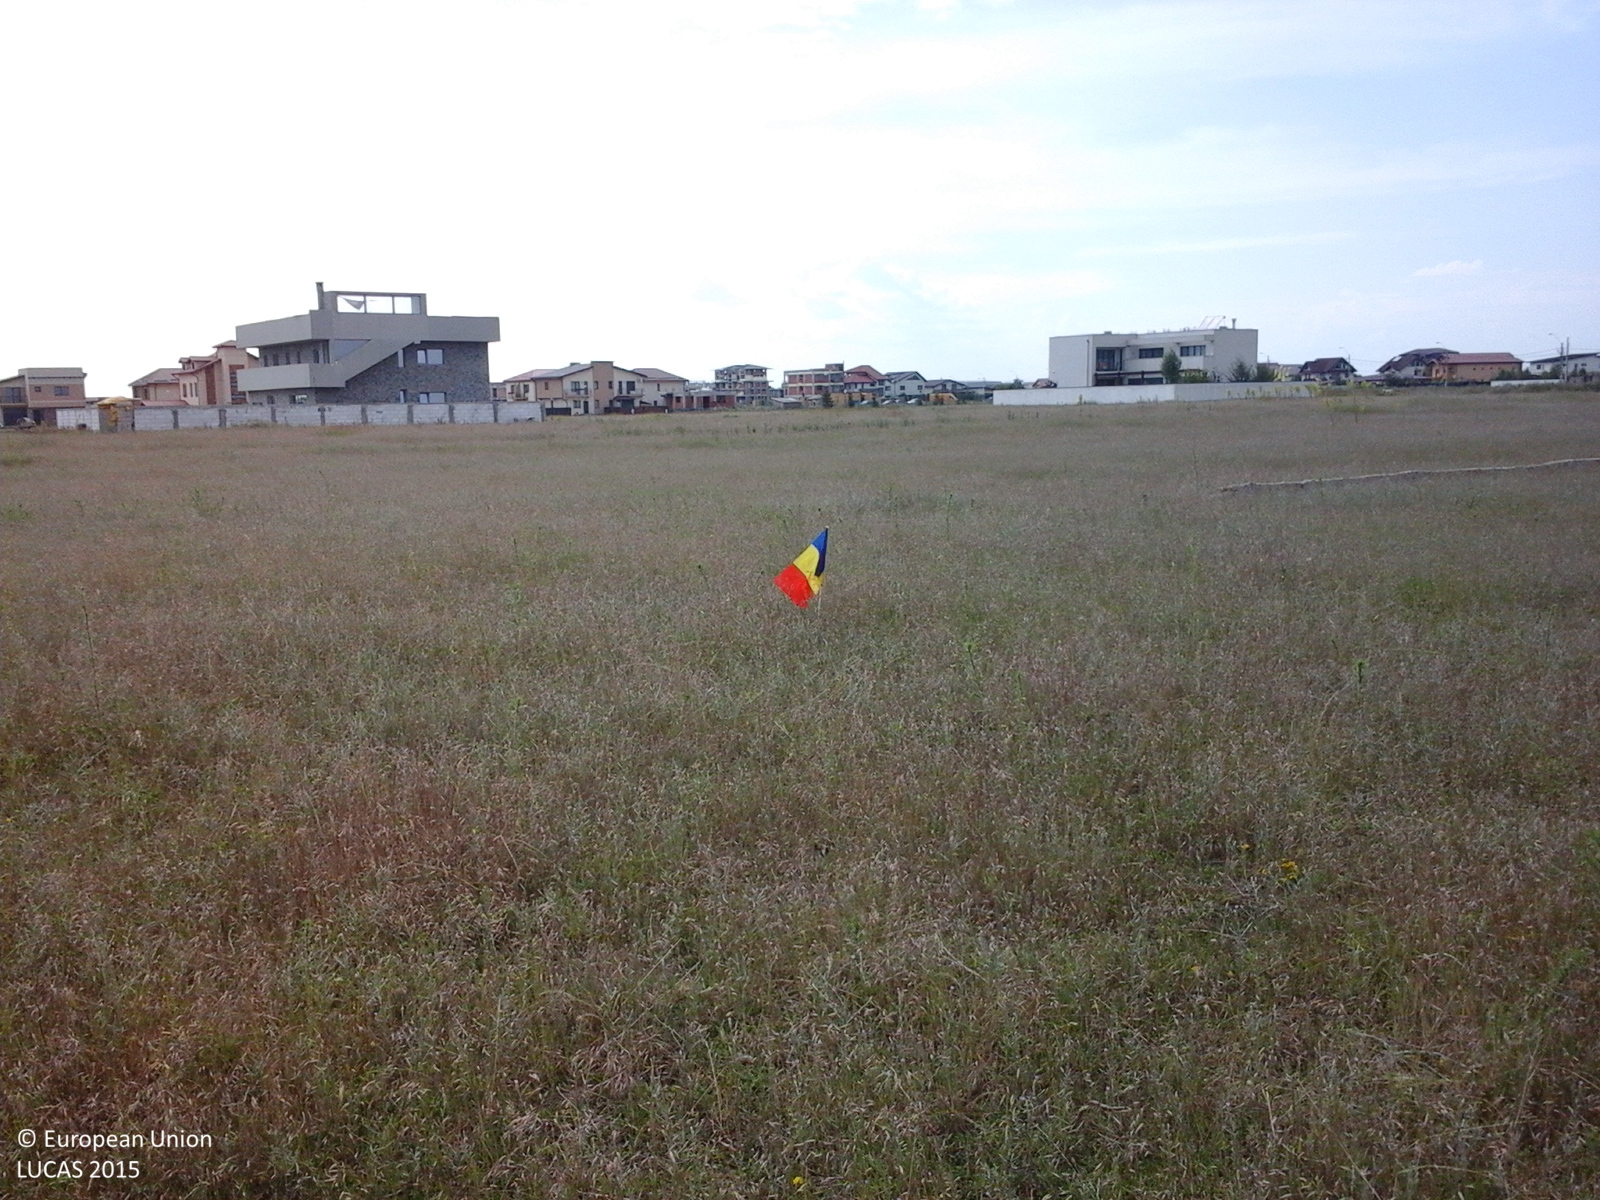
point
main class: Grassland
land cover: Grassland without tree/shrub cover
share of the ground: > 75 %
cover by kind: herbaceous plants 100 %
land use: Agriculture (excluding fallow land and kitchen gardens)
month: June
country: RO
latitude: 44.5514
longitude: 26.1058
